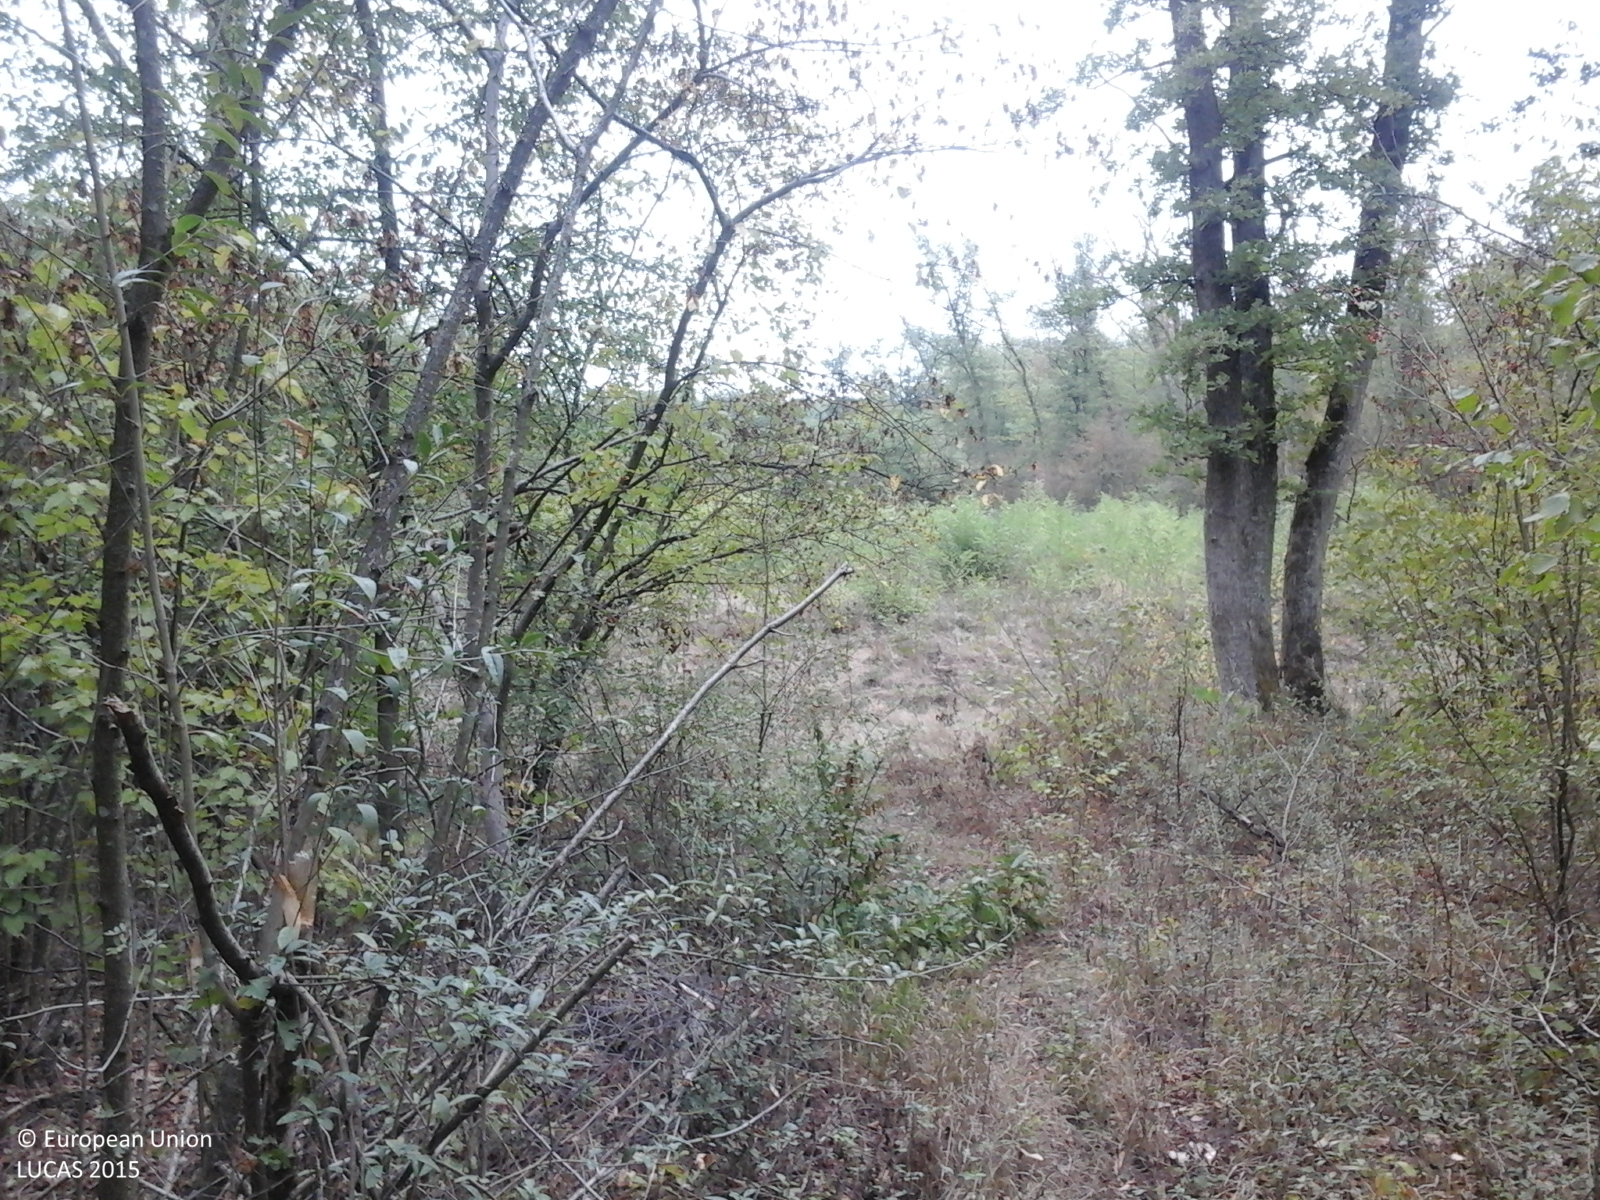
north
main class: Woodland
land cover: Broadleaved woodland
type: mesophytic deciduous forest
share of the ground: > 75 %
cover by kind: broadleaved forest trees 100 %
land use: Forestry
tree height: > 5 m
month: September
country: RO
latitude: 47.7279
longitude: 22.3352
